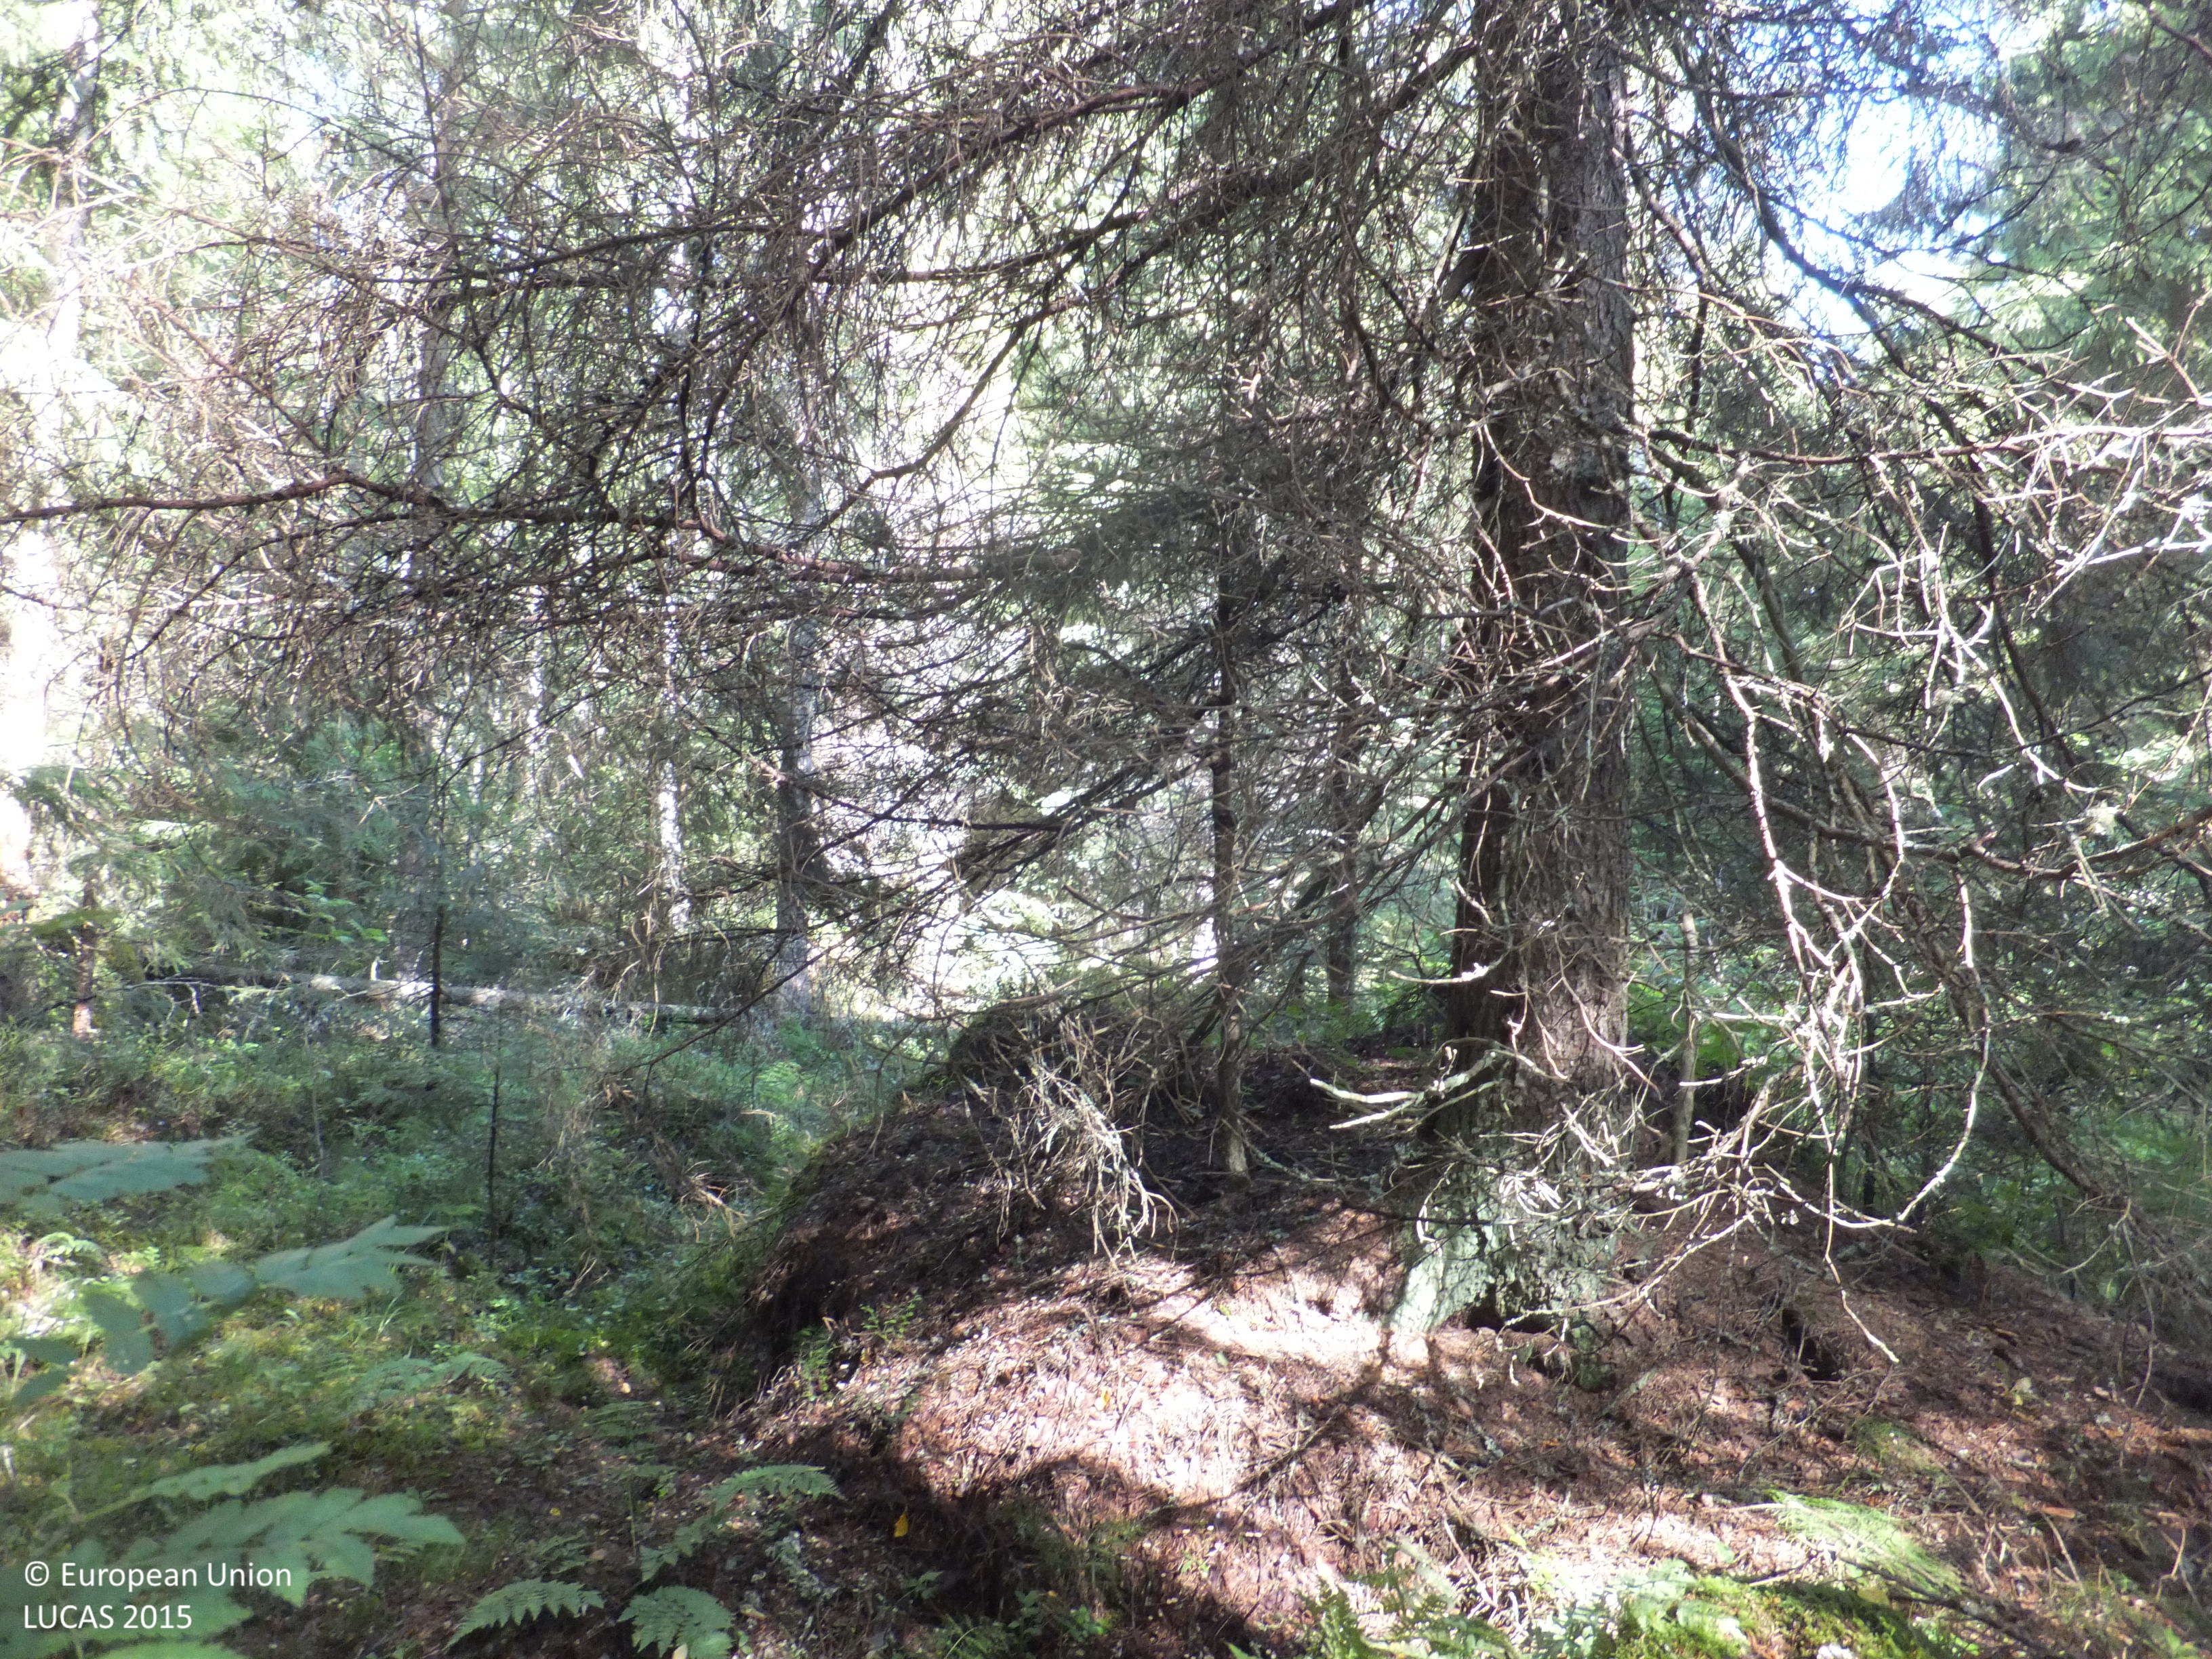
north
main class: Woodland
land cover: Spruce dominated mixed woodland
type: boreal forest
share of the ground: > 75 %
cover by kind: coniferous forest trees 55 %, broadleaved forest trees 30 %, shrubs 5 %, herbaceous plants 5 %, lichens and mosses 5 %
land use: Forestry
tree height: > 5 m
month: August
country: FI
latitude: 63.1233
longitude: 22.1606
